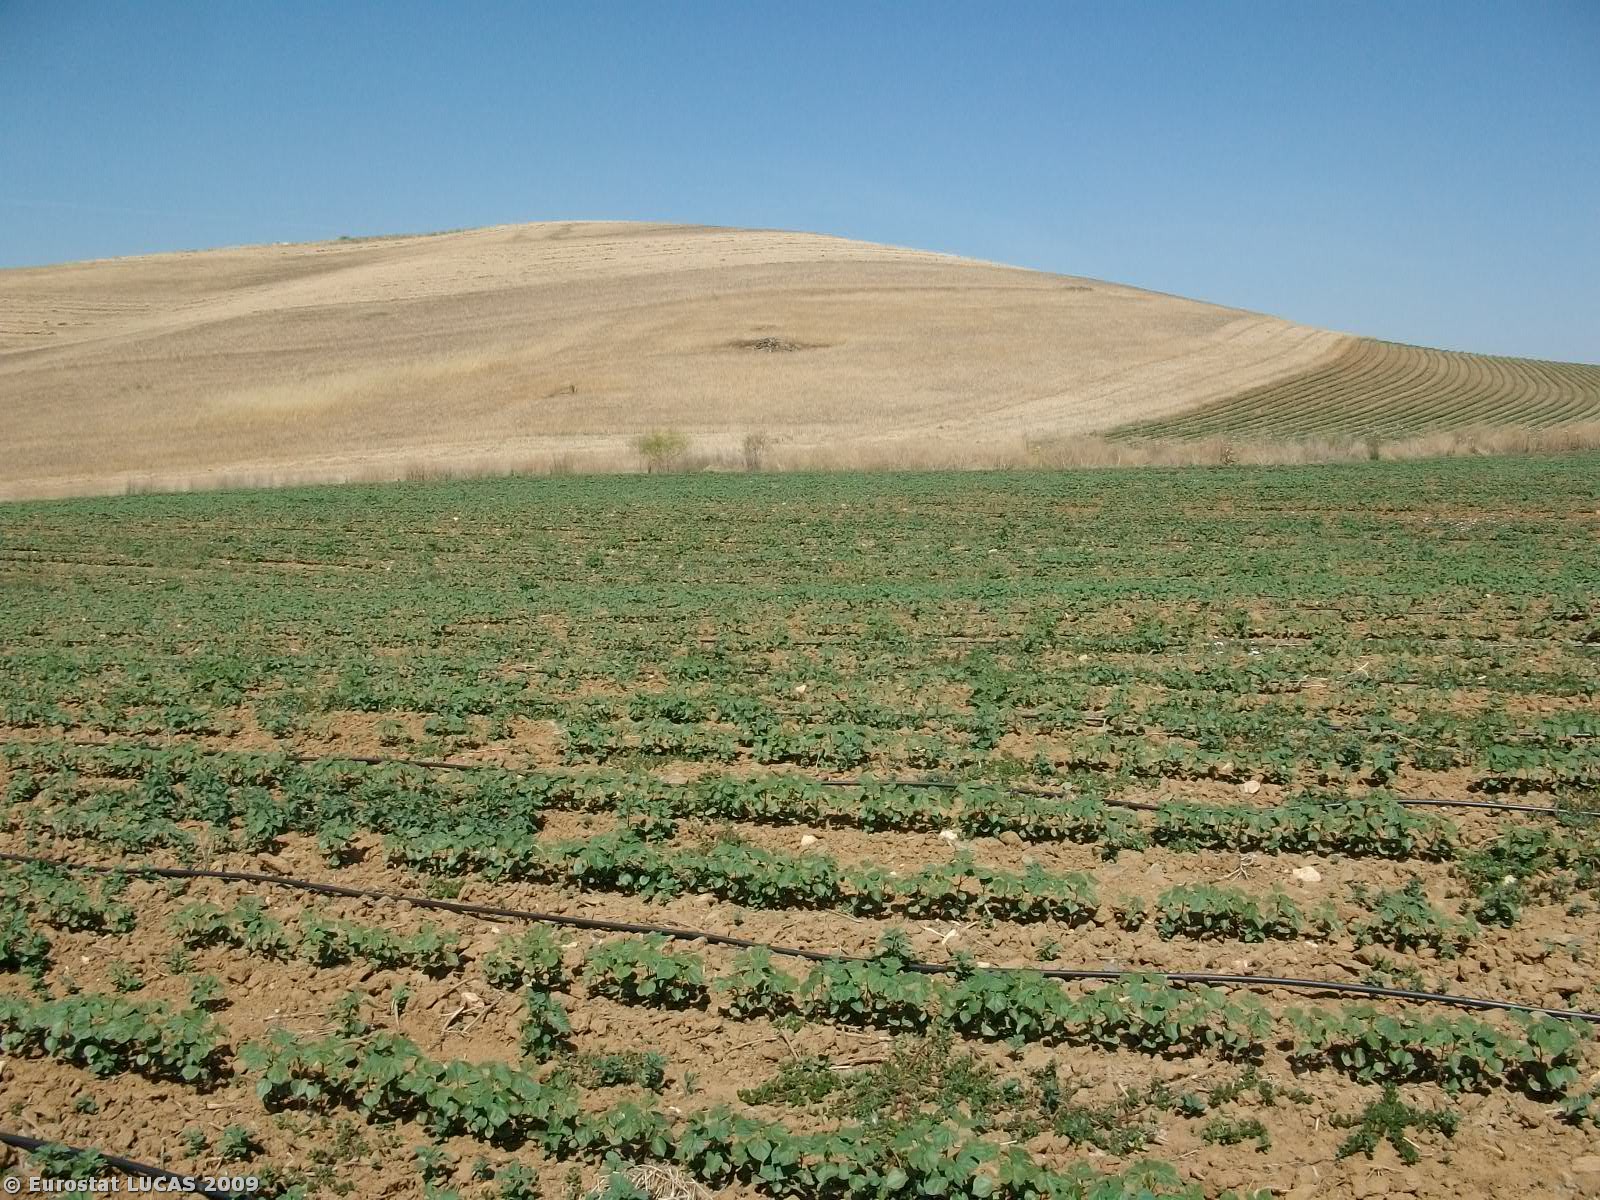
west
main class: Cropland
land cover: Cotton
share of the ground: 10 - 25 %
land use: Agriculture (excluding fallow land and kitchen gardens)
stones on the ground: 10 - 25 %
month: April
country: GR
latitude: 39.3685
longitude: 22.5348
